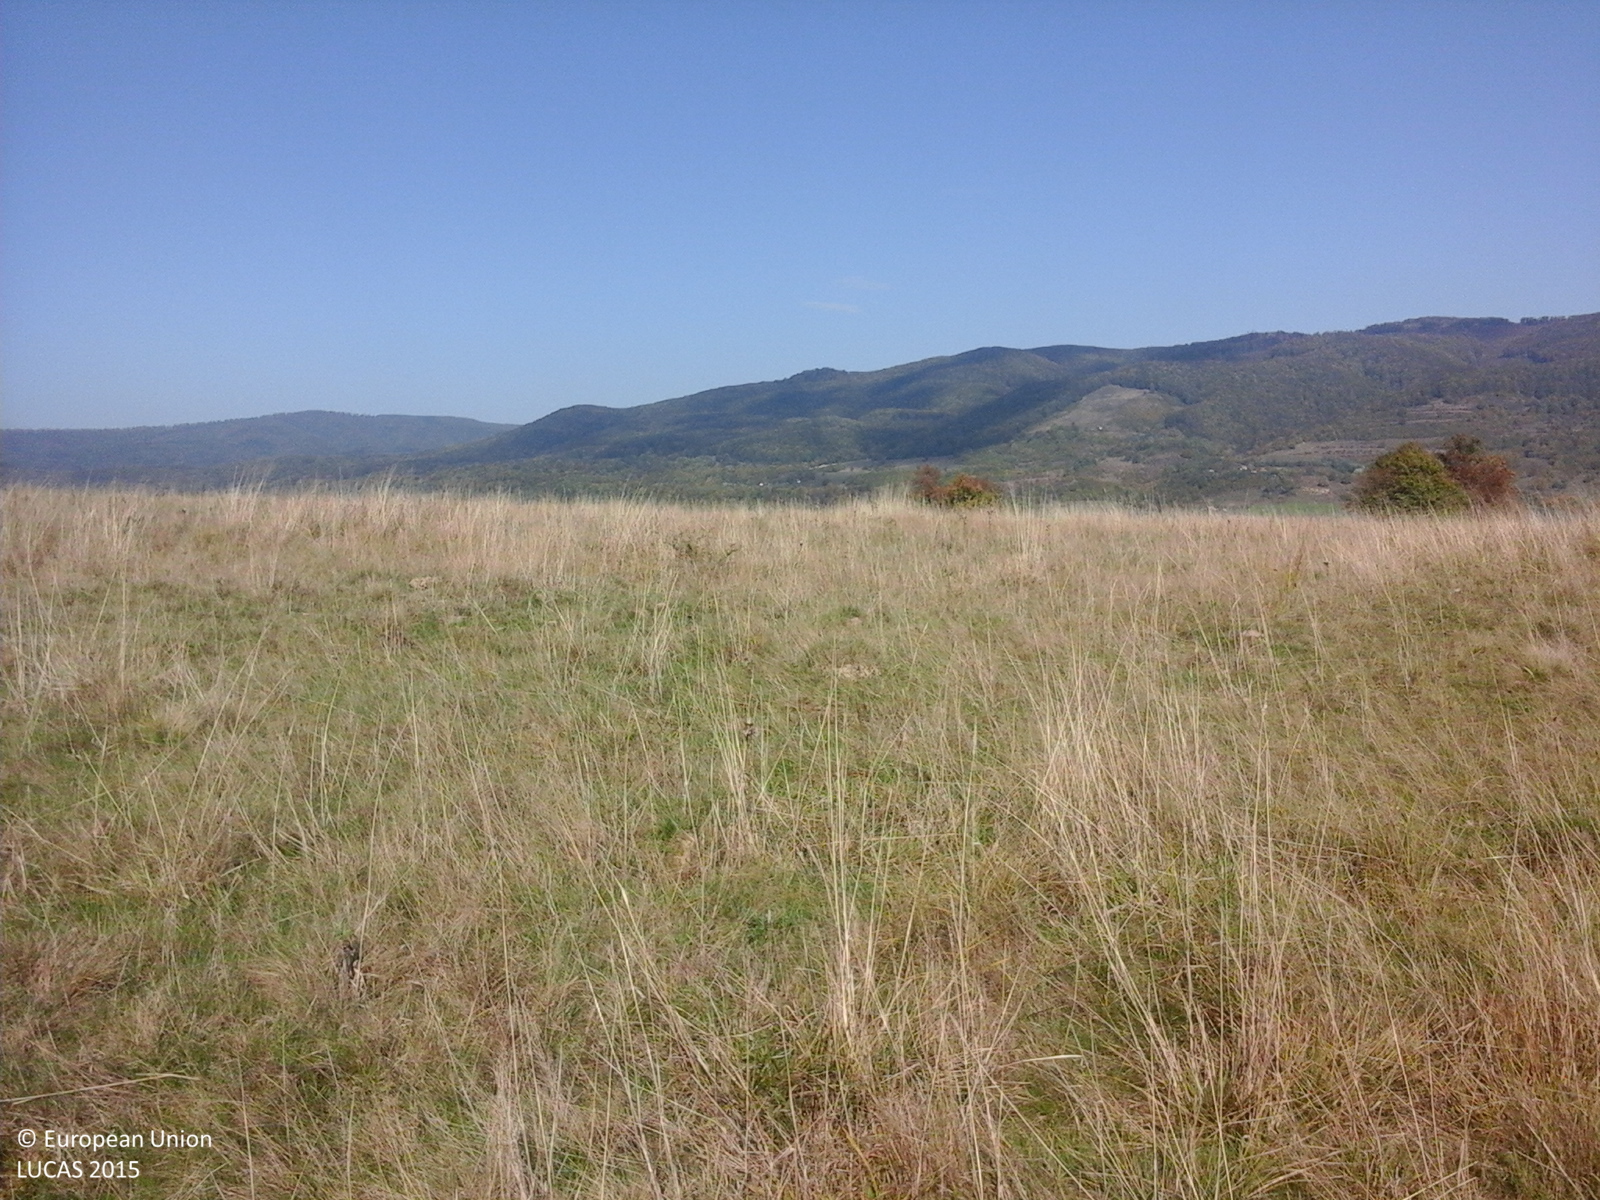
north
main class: Grassland
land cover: Grassland without tree/shrub cover
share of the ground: > 75 %
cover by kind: herbaceous plants 100 %
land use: Agriculture (excluding fallow land and kitchen gardens)
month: October
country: RO
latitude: 46.6152
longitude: 25.0506
